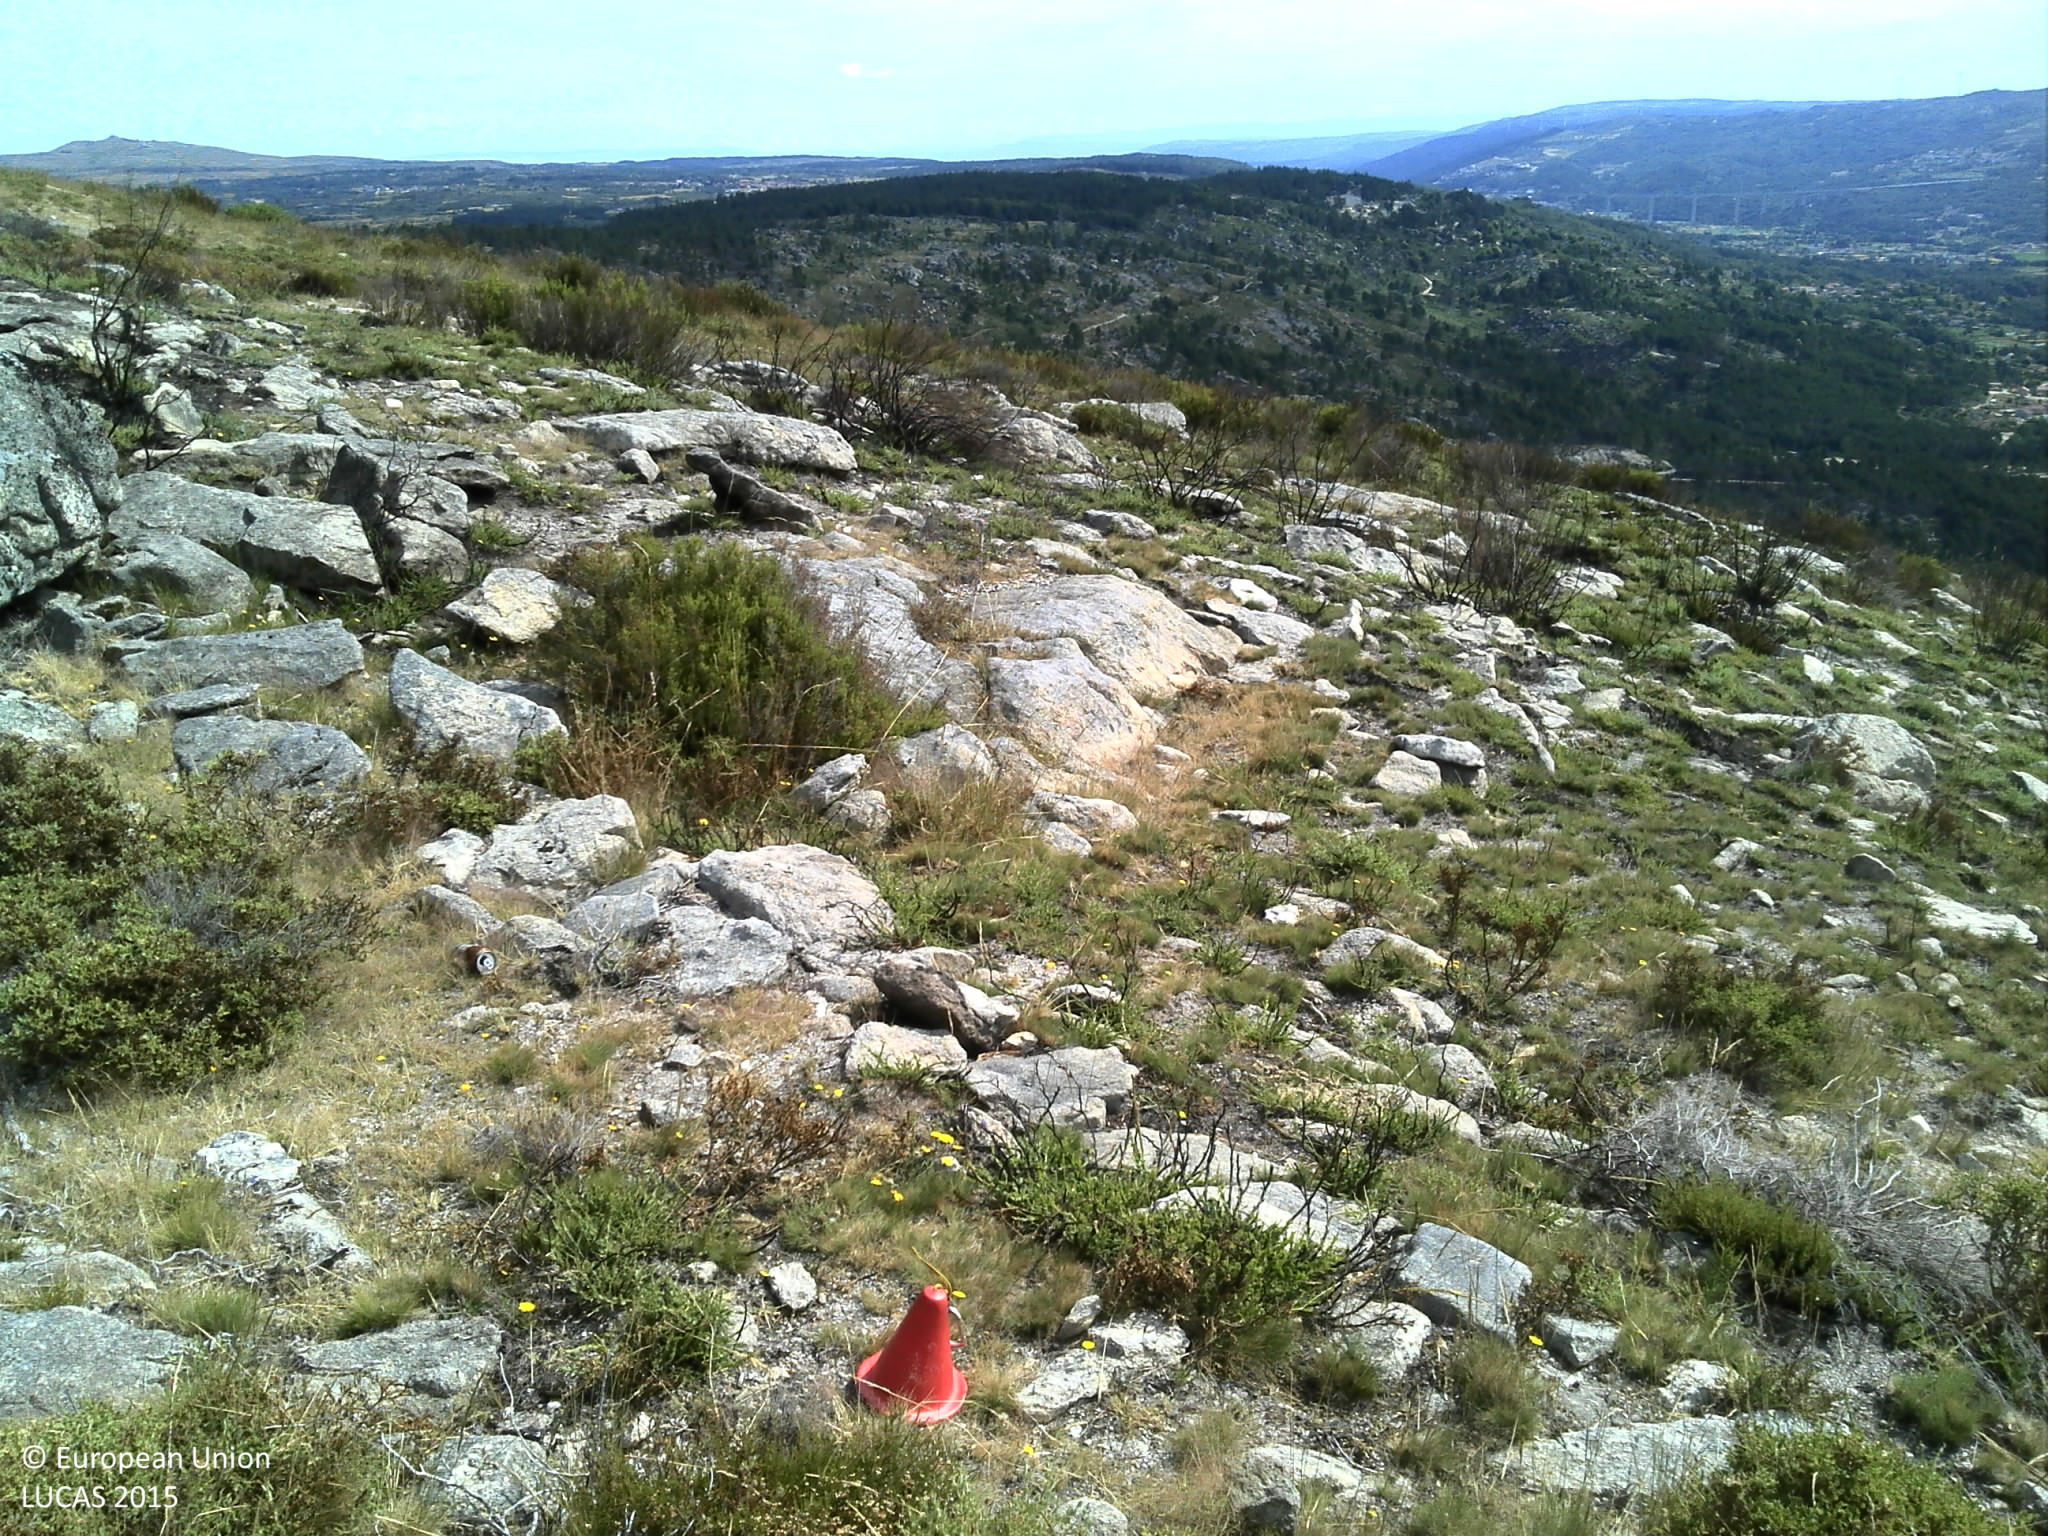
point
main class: Shrubland
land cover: Shrubland without tree cover
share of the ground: 50 - 75 %
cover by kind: shrubs 60 %, consolidated bare surface 30 %, unconsolidated bare surface 10 %
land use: Agriculture (excluding fallow land and kitchen gardens)
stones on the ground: 25 - 50 %
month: July
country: PT
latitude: 41.4466
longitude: -7.7155
